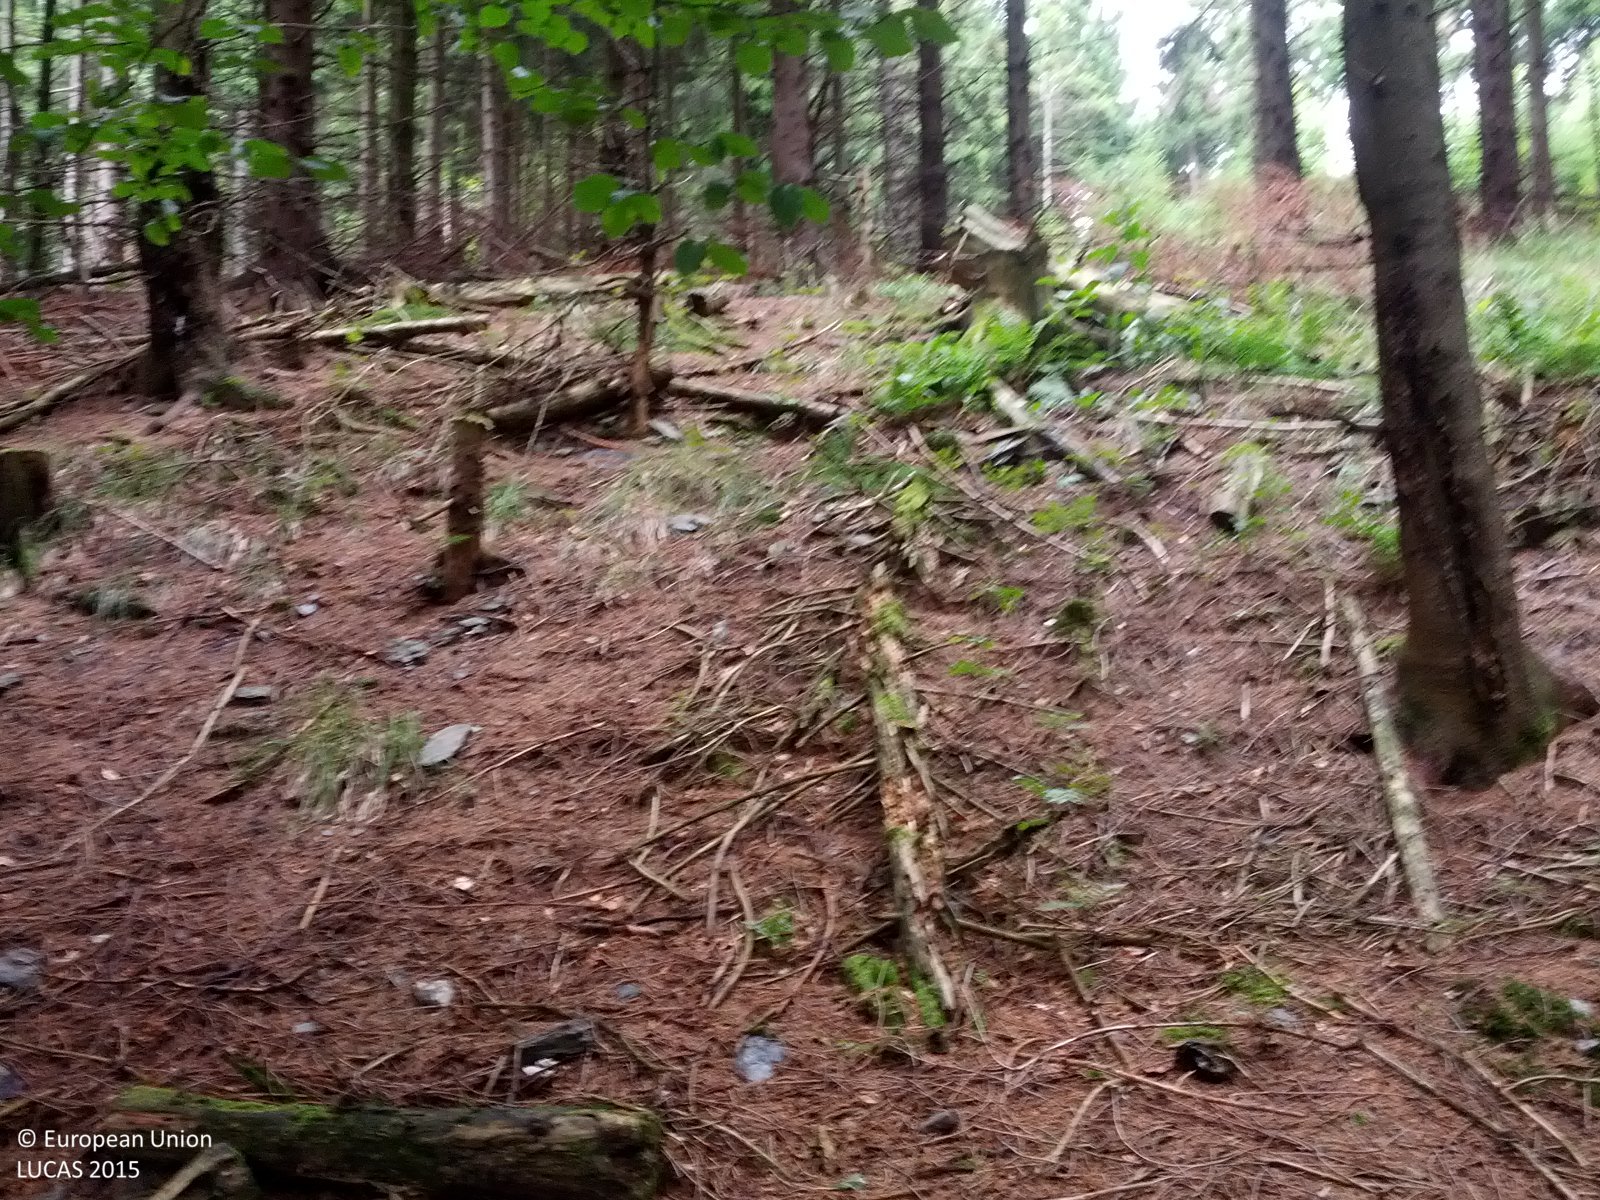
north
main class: Woodland
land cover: Spruce dominated coniferous woodland
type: alpine coniferous forest
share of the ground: > 75 %
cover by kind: coniferous forest trees 90 %, shrubs 5 %, unconsolidated bare surface 5 %
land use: Forestry
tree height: > 5 m
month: July
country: AT
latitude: 47.3501
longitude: 16.4234
